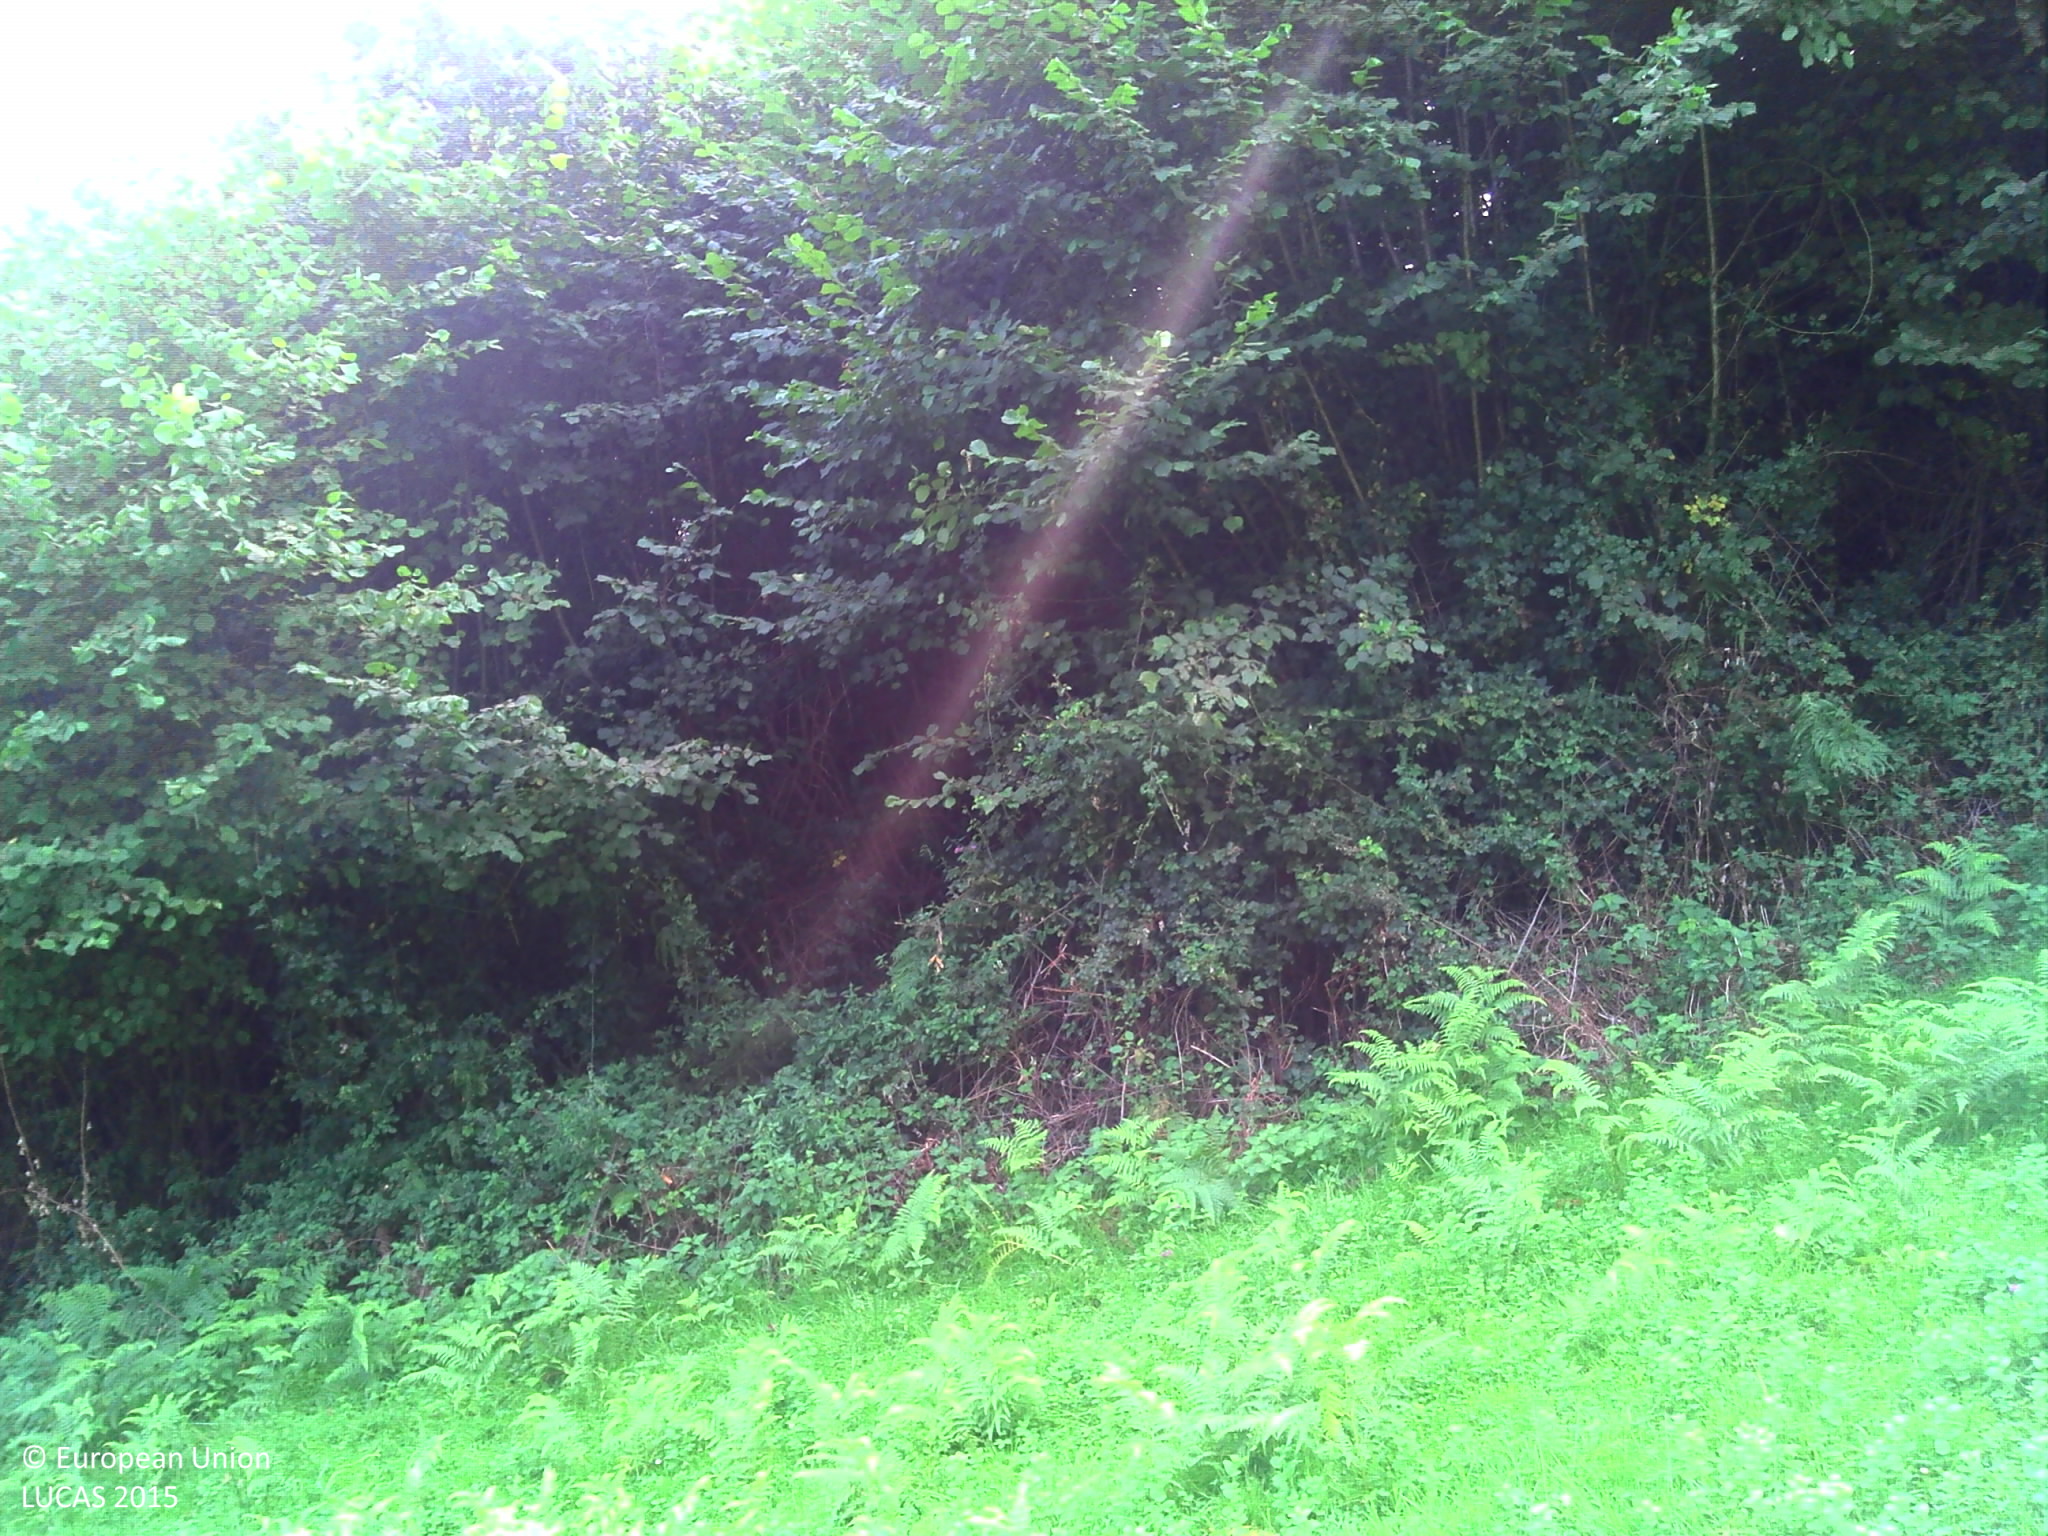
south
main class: Grassland
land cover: Grassland without tree/shrub cover
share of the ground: > 75 %
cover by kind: herbaceous plants 100 %
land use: Agriculture (excluding fallow land and kitchen gardens)
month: September
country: FR
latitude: 43.1615
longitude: -1.0189
